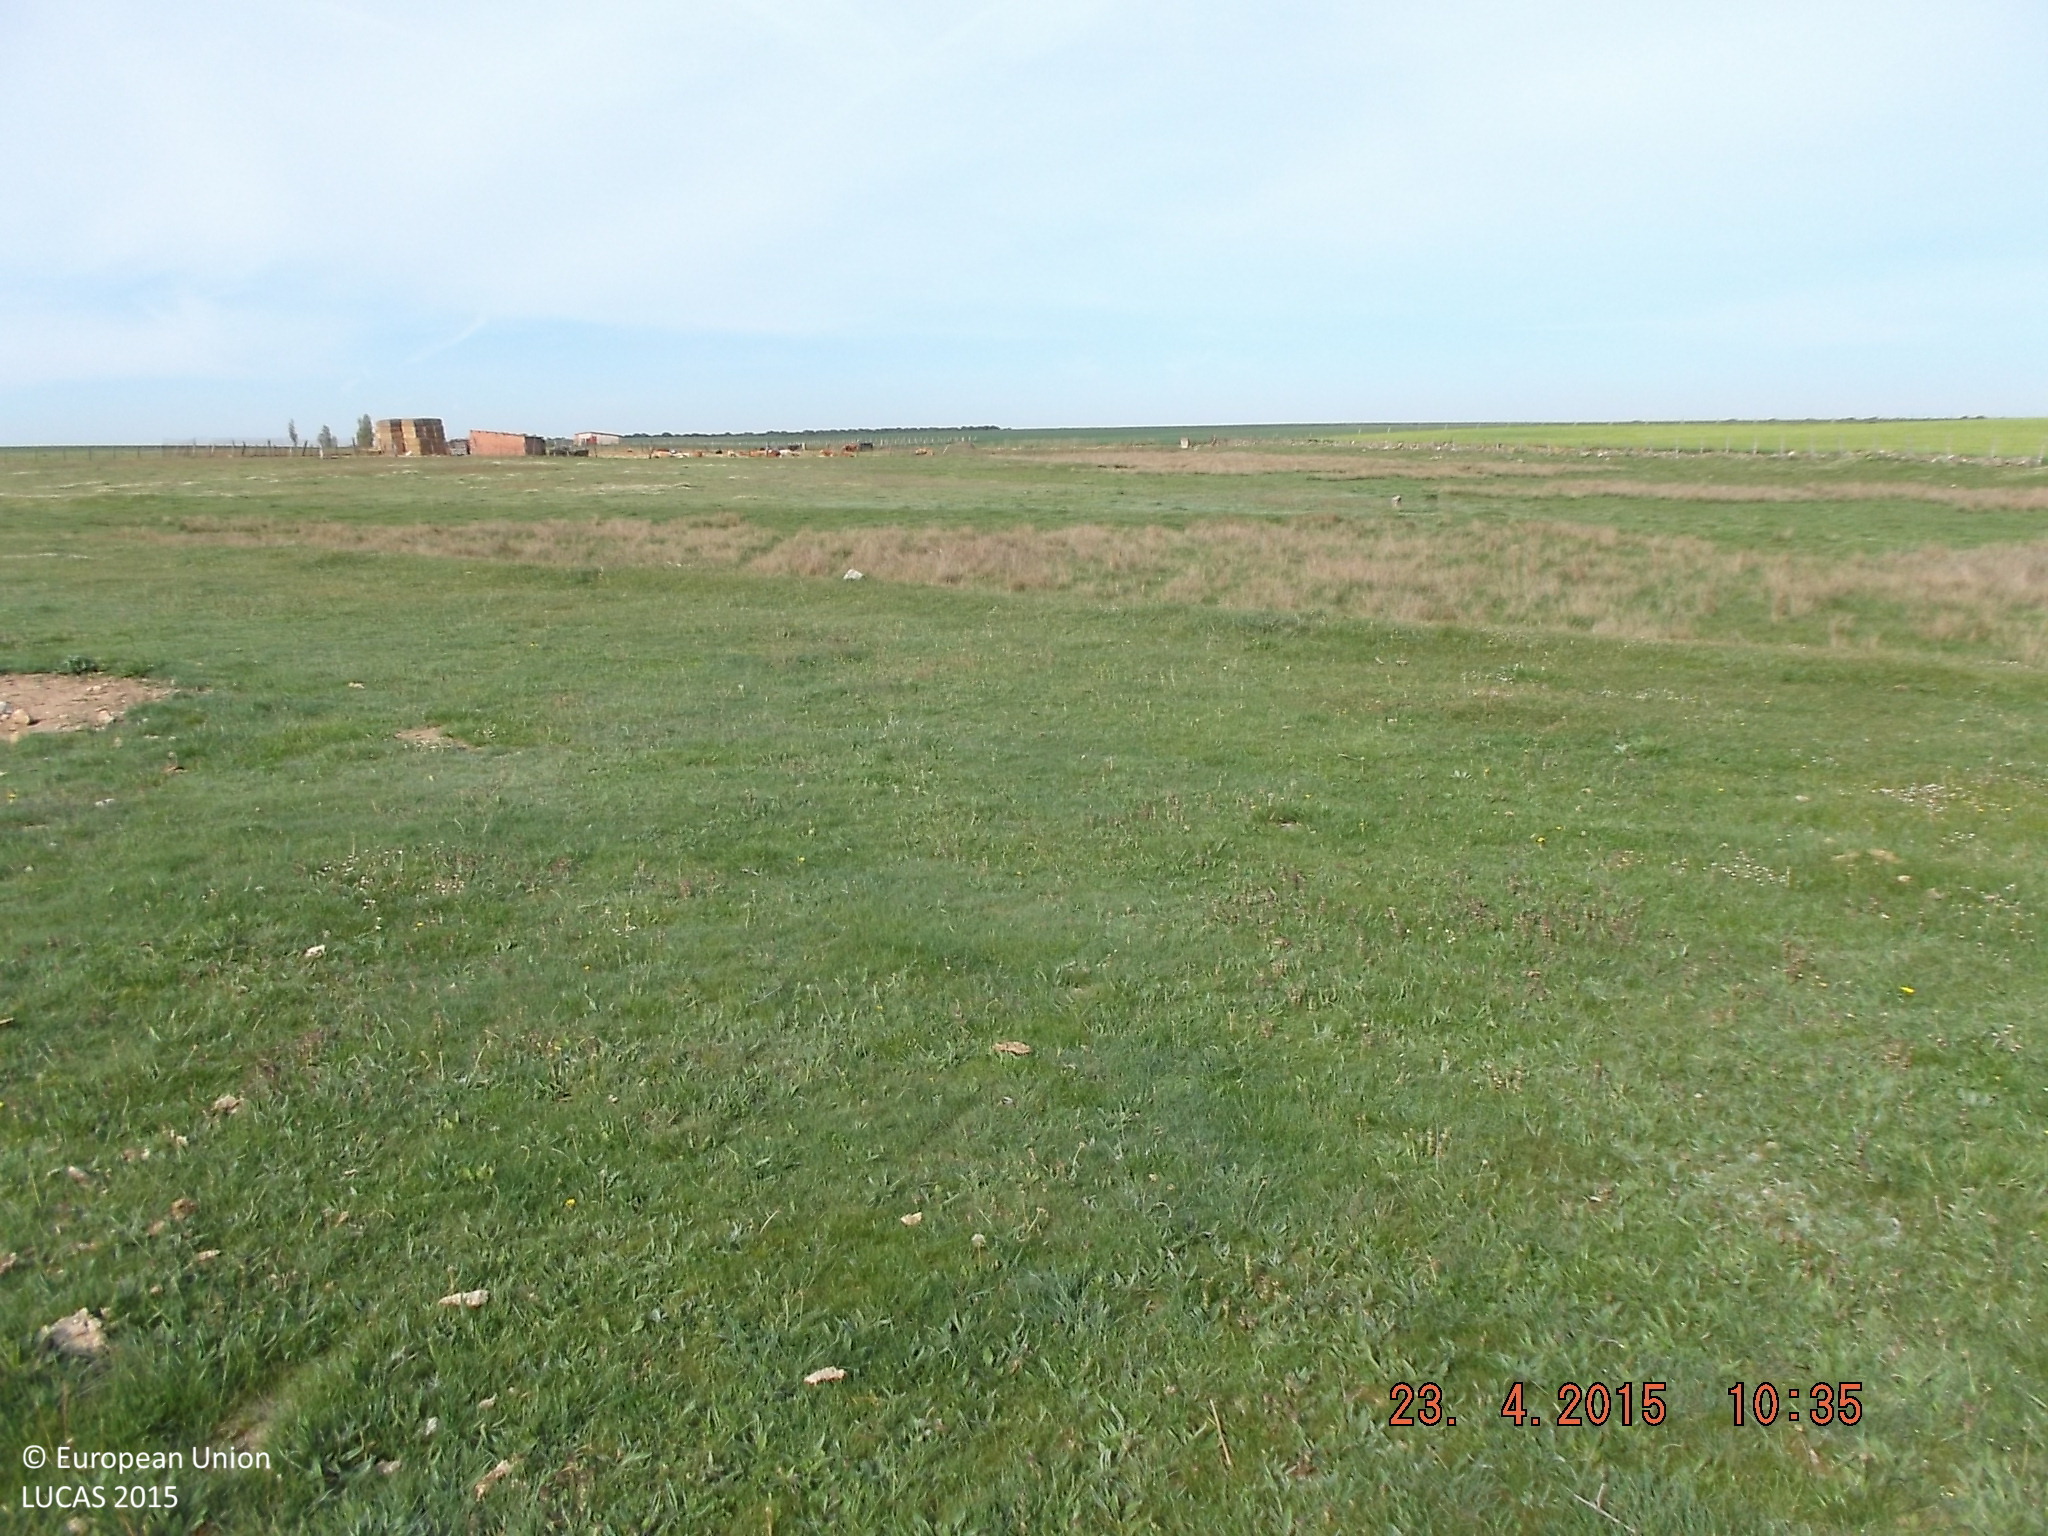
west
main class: Grassland
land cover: Grassland without tree/shrub cover
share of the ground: > 75 %
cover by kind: herbaceous plants 100 %
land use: Agriculture (excluding fallow land and kitchen gardens)
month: April
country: ES
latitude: 40.9450
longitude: -5.9162
